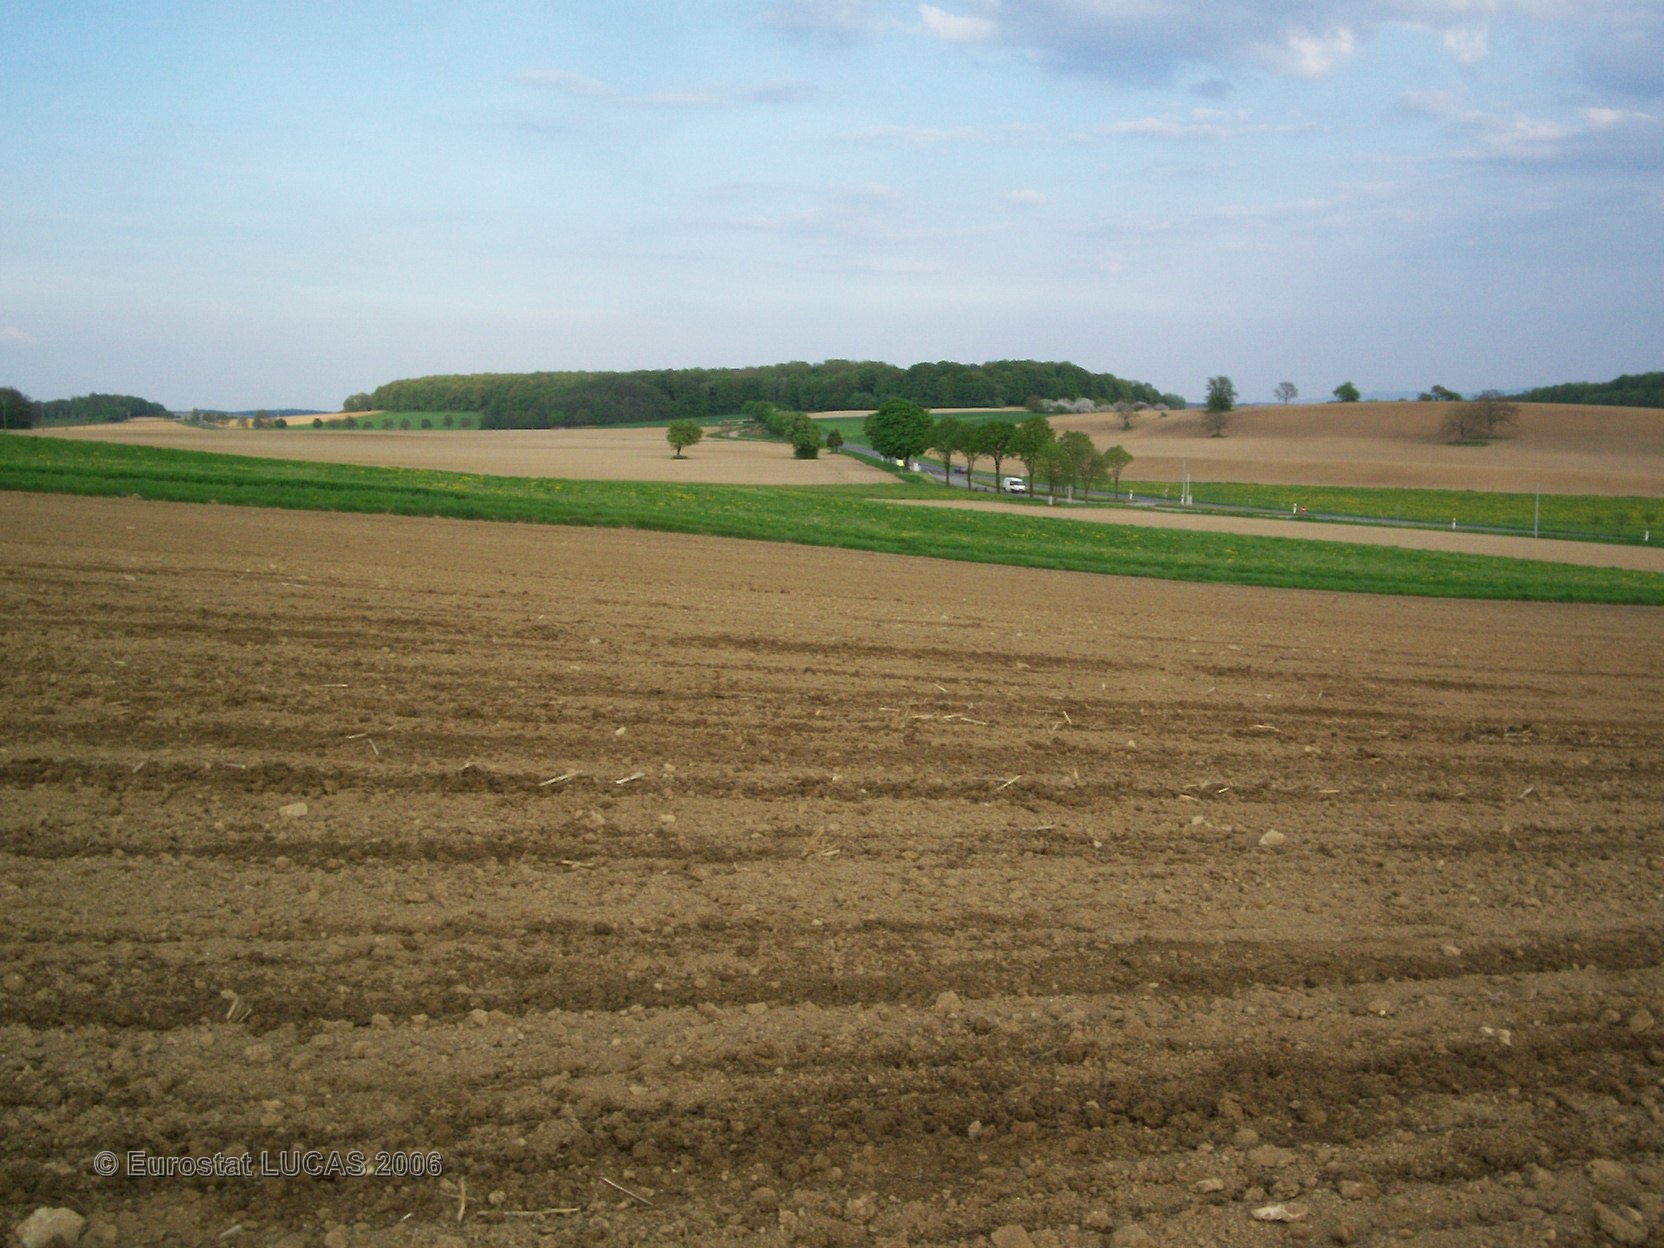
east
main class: Cropland
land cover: Maize
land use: Agriculture (excluding fallow land and kitchen gardens)
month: May
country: FR
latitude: 47.6289
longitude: 7.1670
